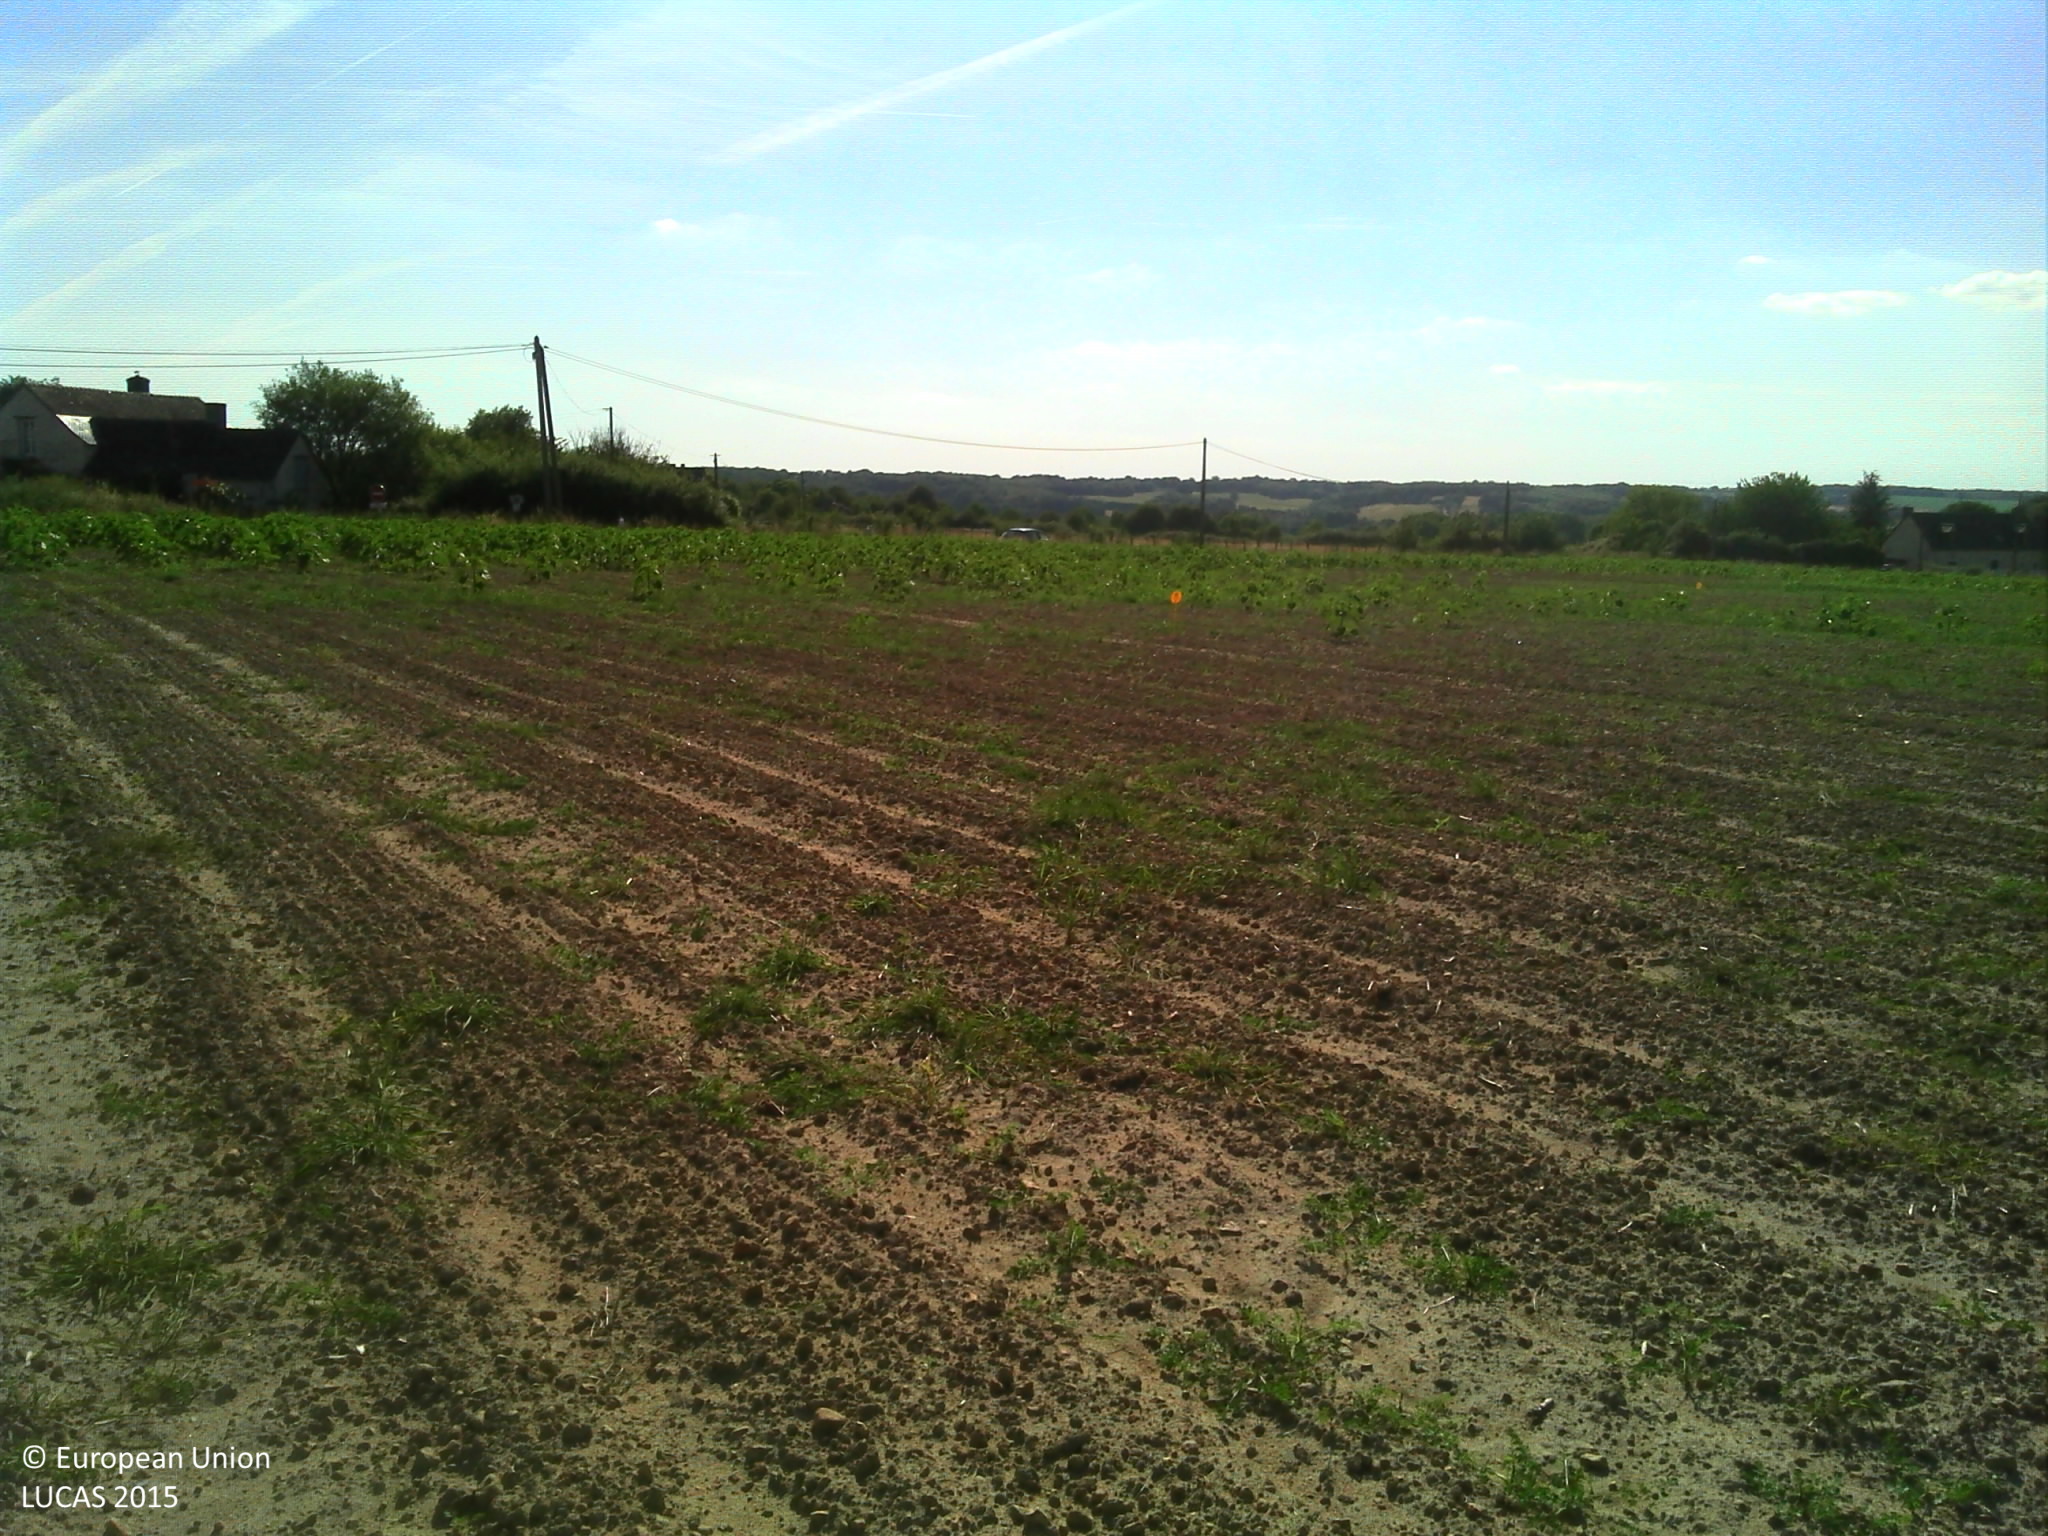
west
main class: Cropland
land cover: Sunflower
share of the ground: 10 - 25 %
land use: Agriculture (excluding fallow land and kitchen gardens)
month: June
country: FR
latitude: 47.5558
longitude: 0.2618
